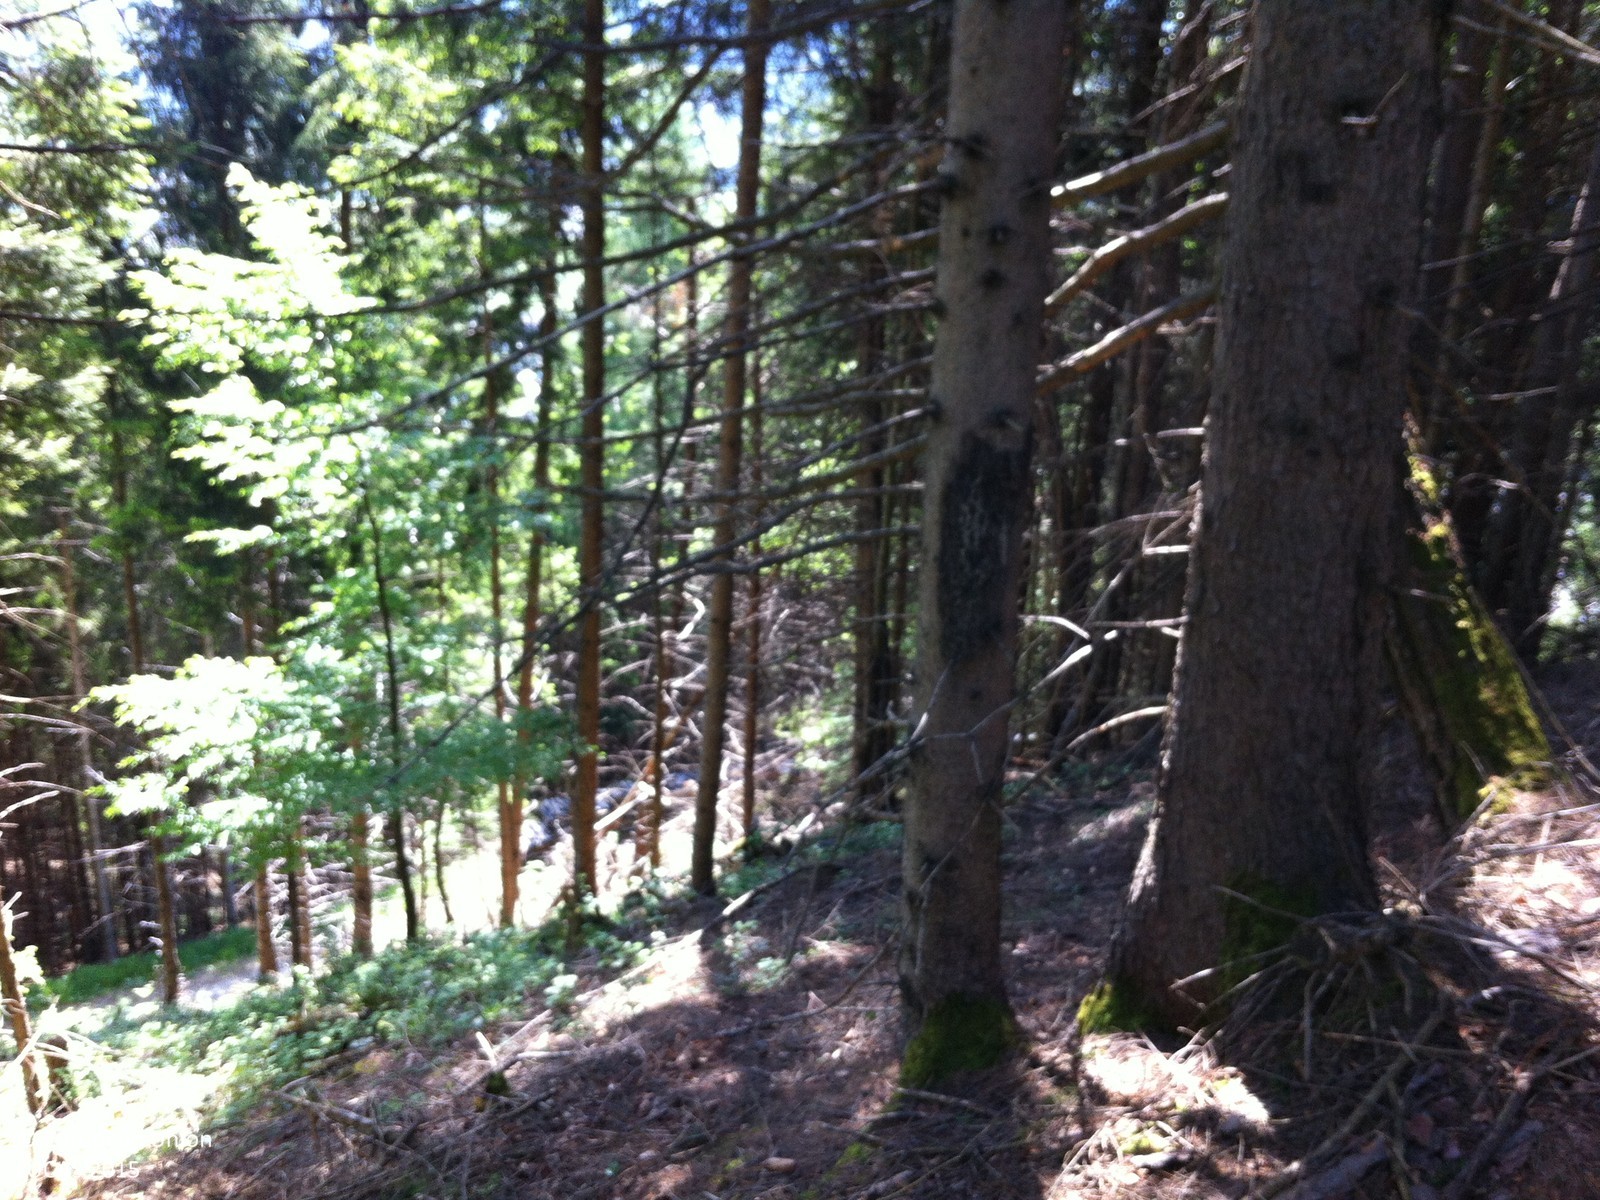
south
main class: Woodland
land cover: Spruce dominated coniferous woodland
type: alpine coniferous forest
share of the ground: > 75 %
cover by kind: coniferous forest trees 100 %
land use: Forestry
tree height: > 5 m
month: May
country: AT
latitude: 47.3466
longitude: 11.6797
